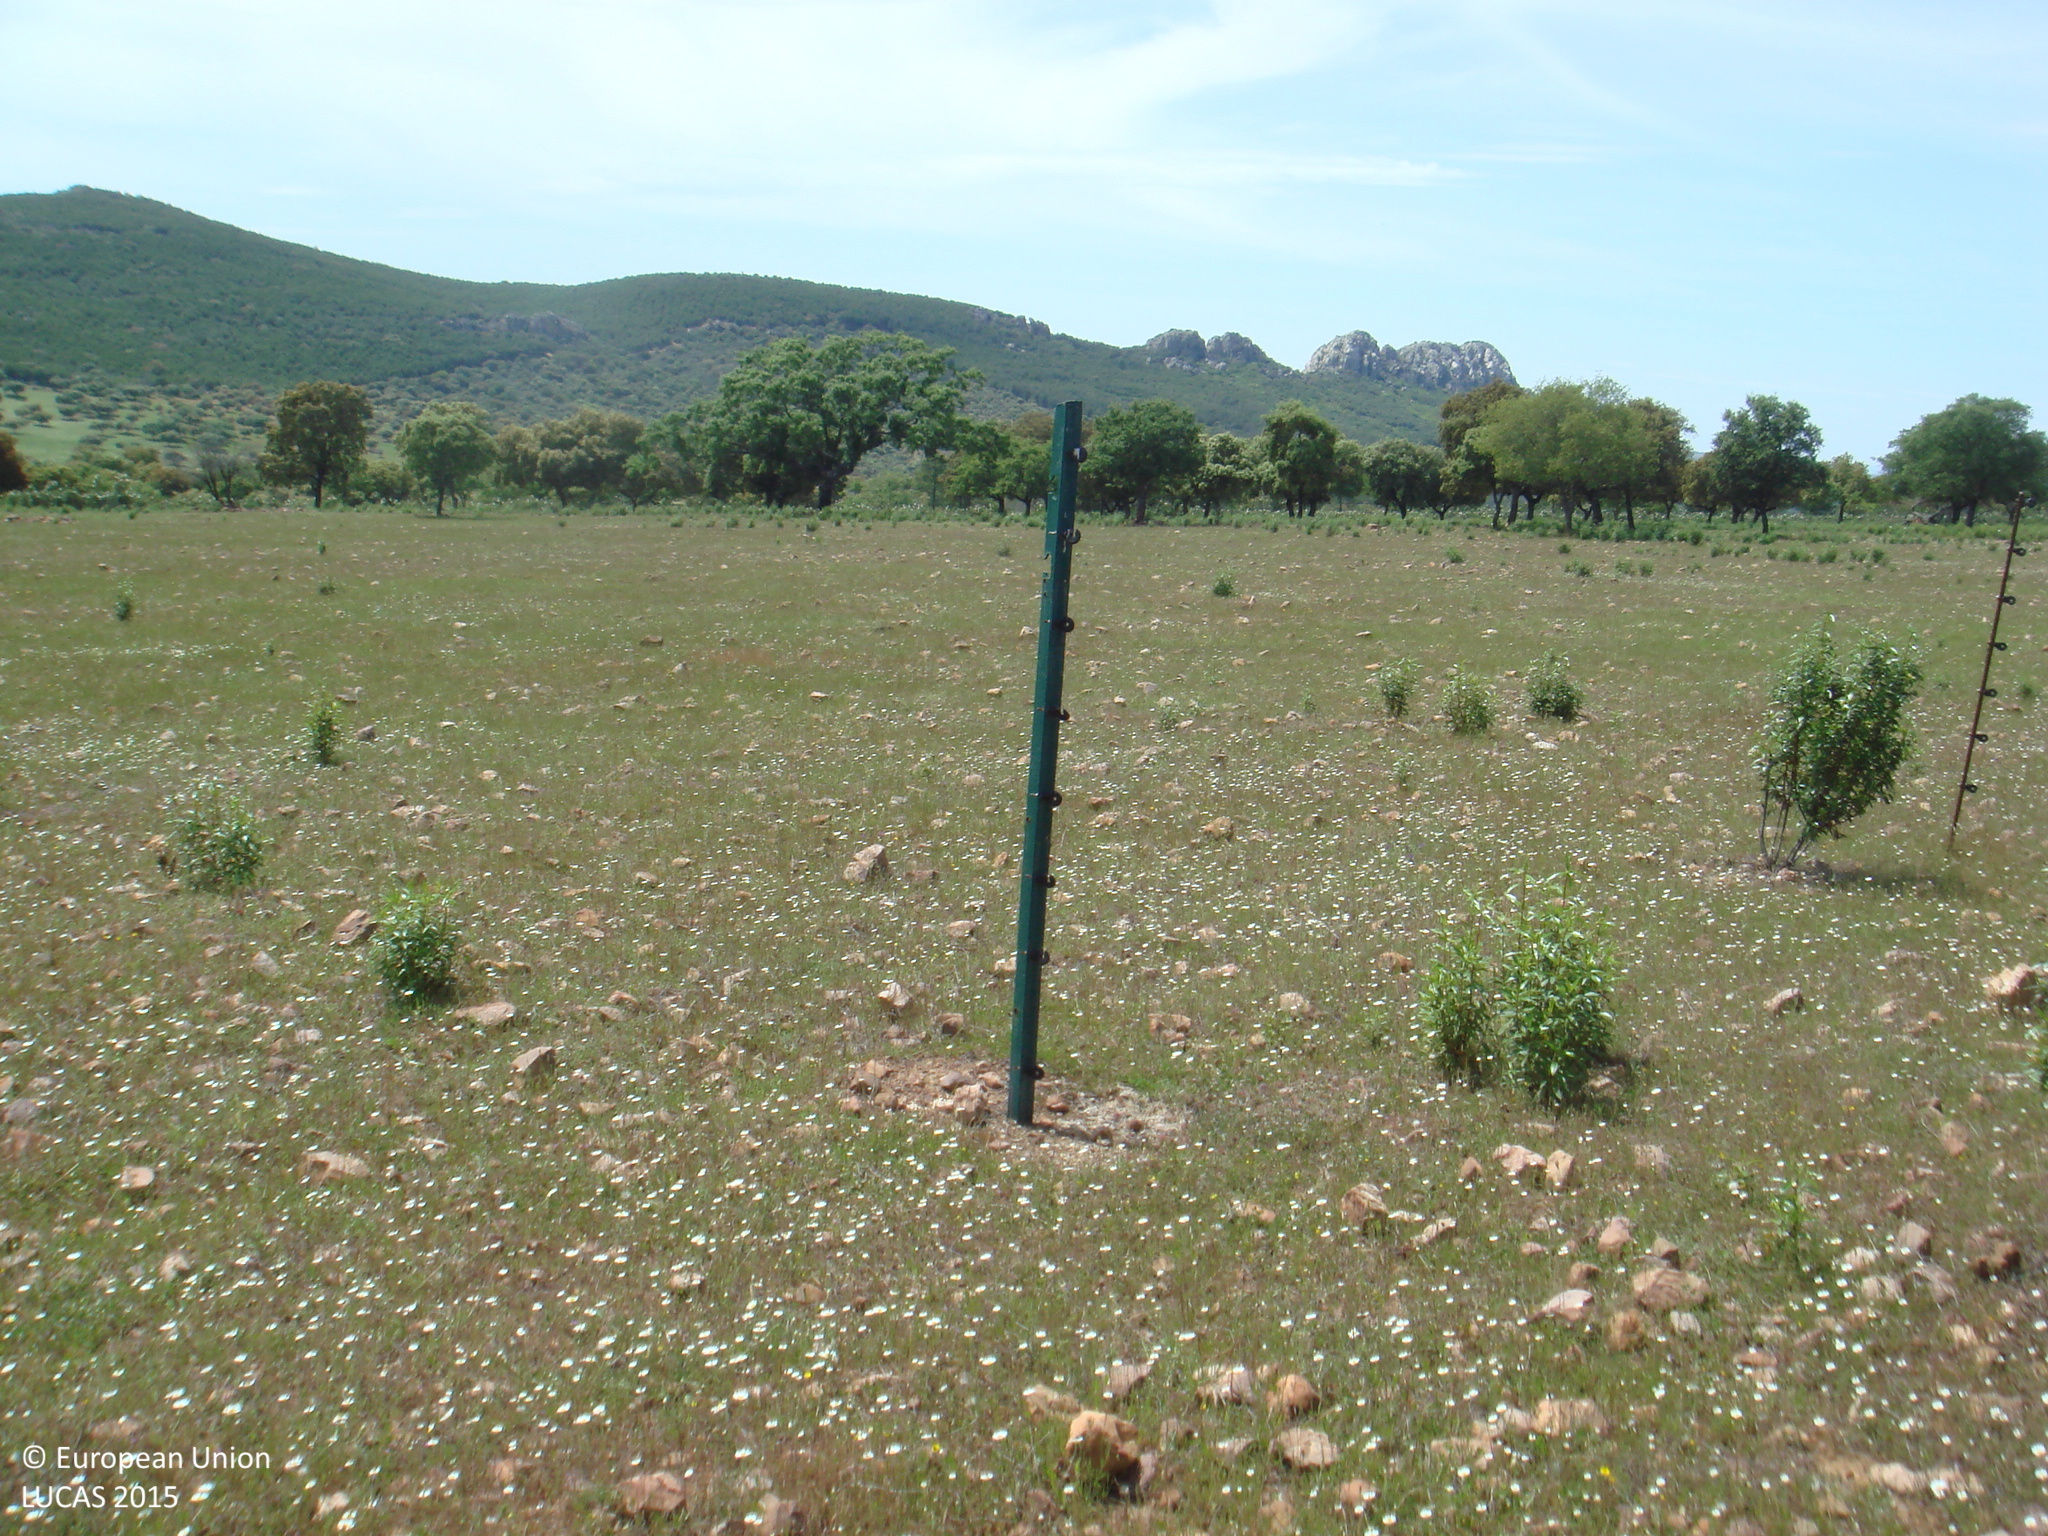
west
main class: Grassland
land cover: Spontaneously vegetated surfaces
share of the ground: > 75 %
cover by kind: herbaceous plants 75 %, unconsolidated bare surface 20 %, shrubs 5 %
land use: Agriculture (excluding fallow land and kitchen gardens)
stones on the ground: 10 - 25 %
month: May
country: ES
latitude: 38.2852
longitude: -5.0819
